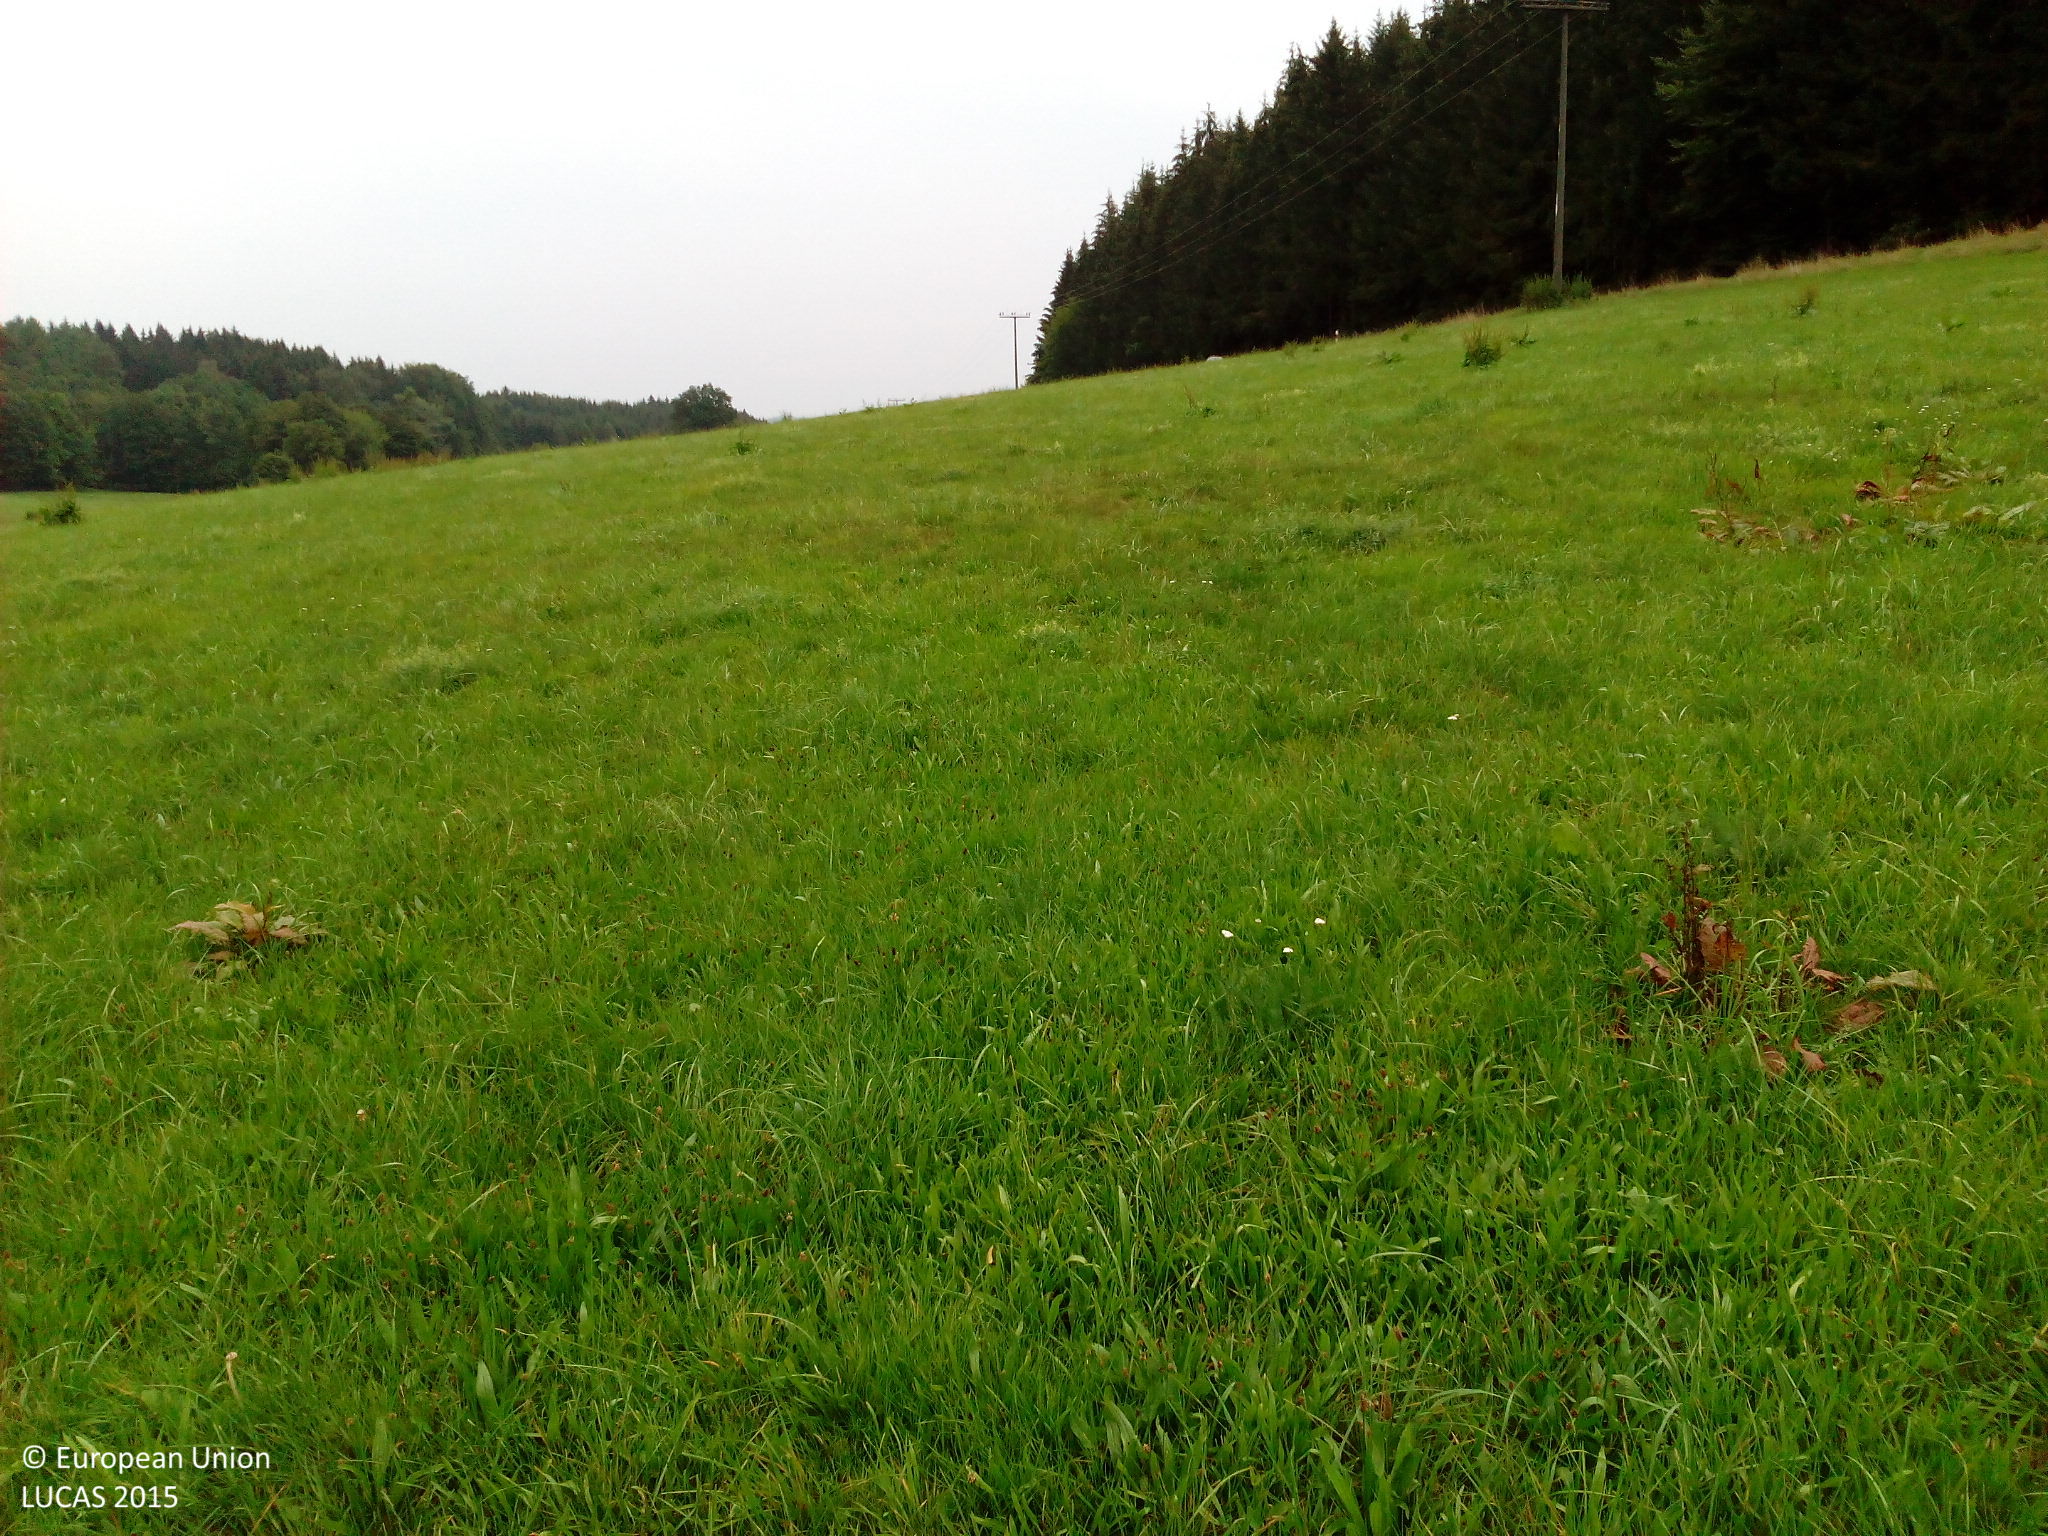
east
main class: Grassland
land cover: Grassland without tree/shrub cover
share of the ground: > 75 %
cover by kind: herbaceous plants 100 %
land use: Agriculture (excluding fallow land and kitchen gardens)
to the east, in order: Grassland without tree/shrub cover; Electric lines; Grass margins; Paved roads, cycling and walking lanes
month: September
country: DE
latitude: 48.3482
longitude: 10.5259
